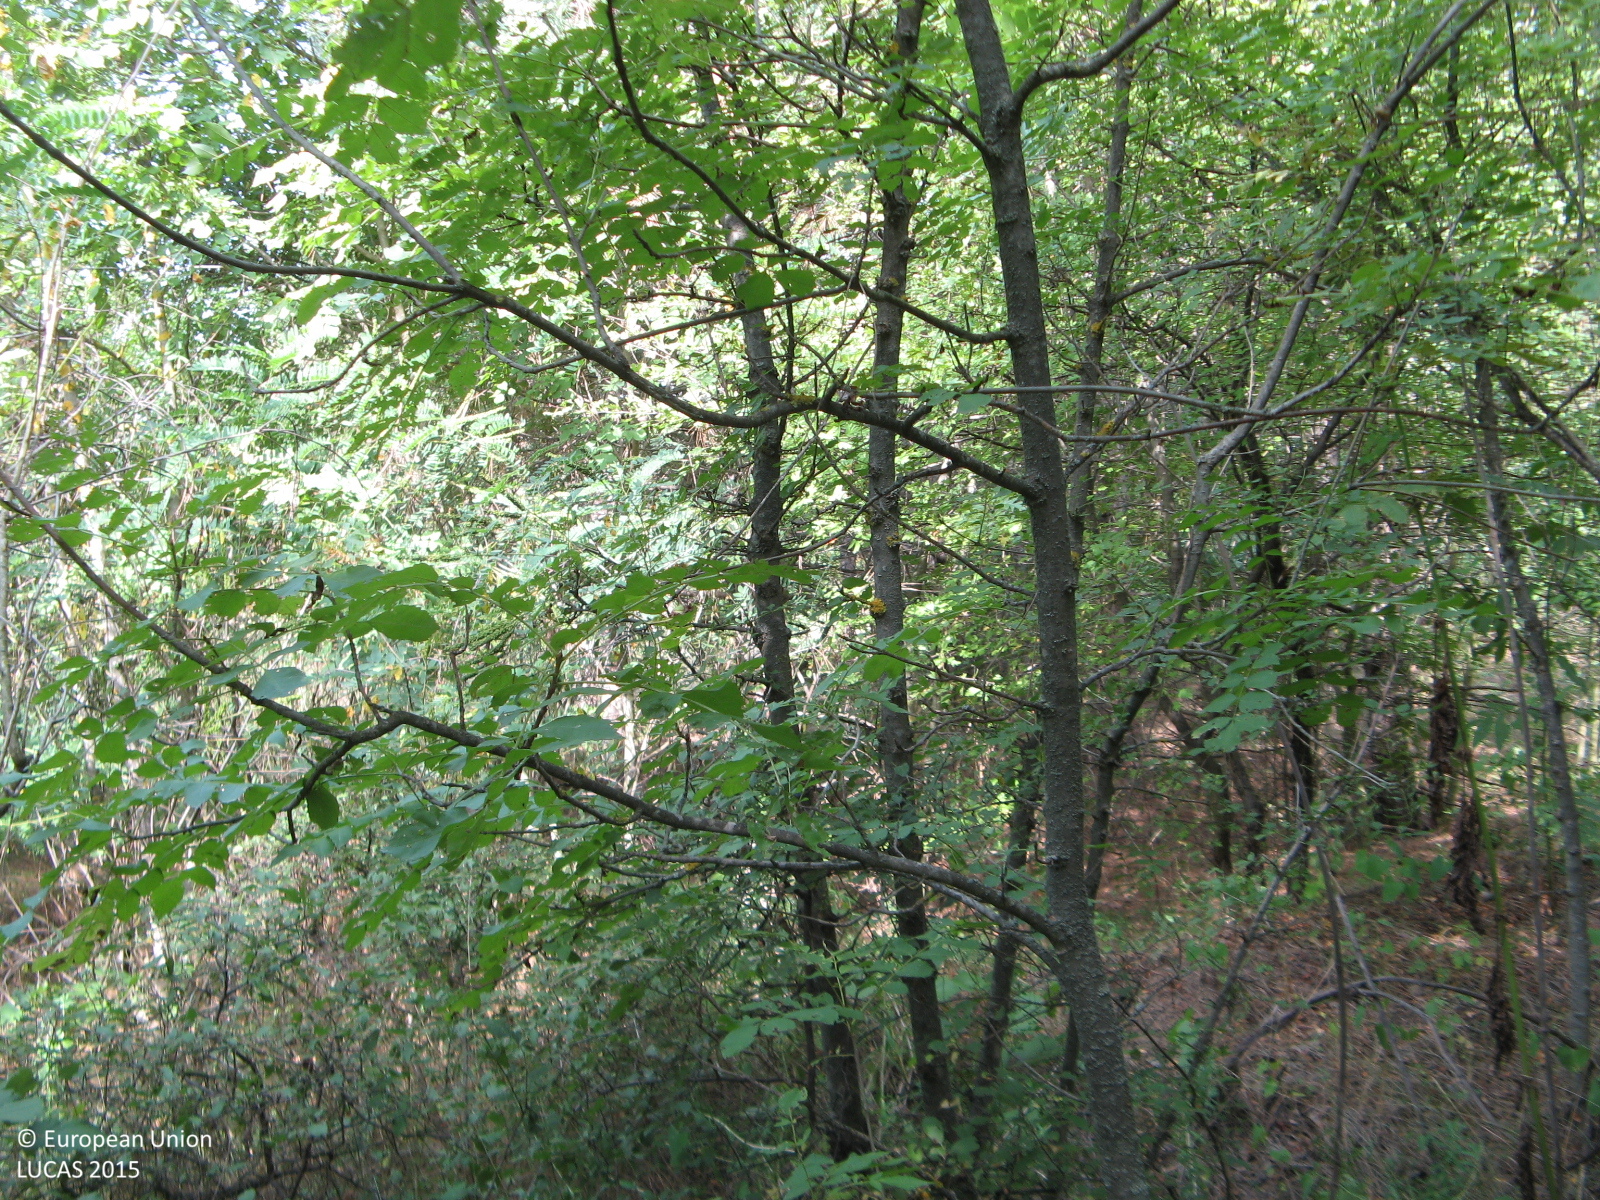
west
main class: Woodland
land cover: Pine dominated mixed woodland
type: hemiboreal forest and nemoral coniferous forest and mixed broadleaved-coniferous forest
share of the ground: 50 - 75 %
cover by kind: coniferous forest trees 60 %, broadleaved forest trees 25 %, herbaceous plants 10 %, shrubs 5 %
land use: Forestry
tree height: > 5 m
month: August
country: BG
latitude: 43.6238
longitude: 25.8164
